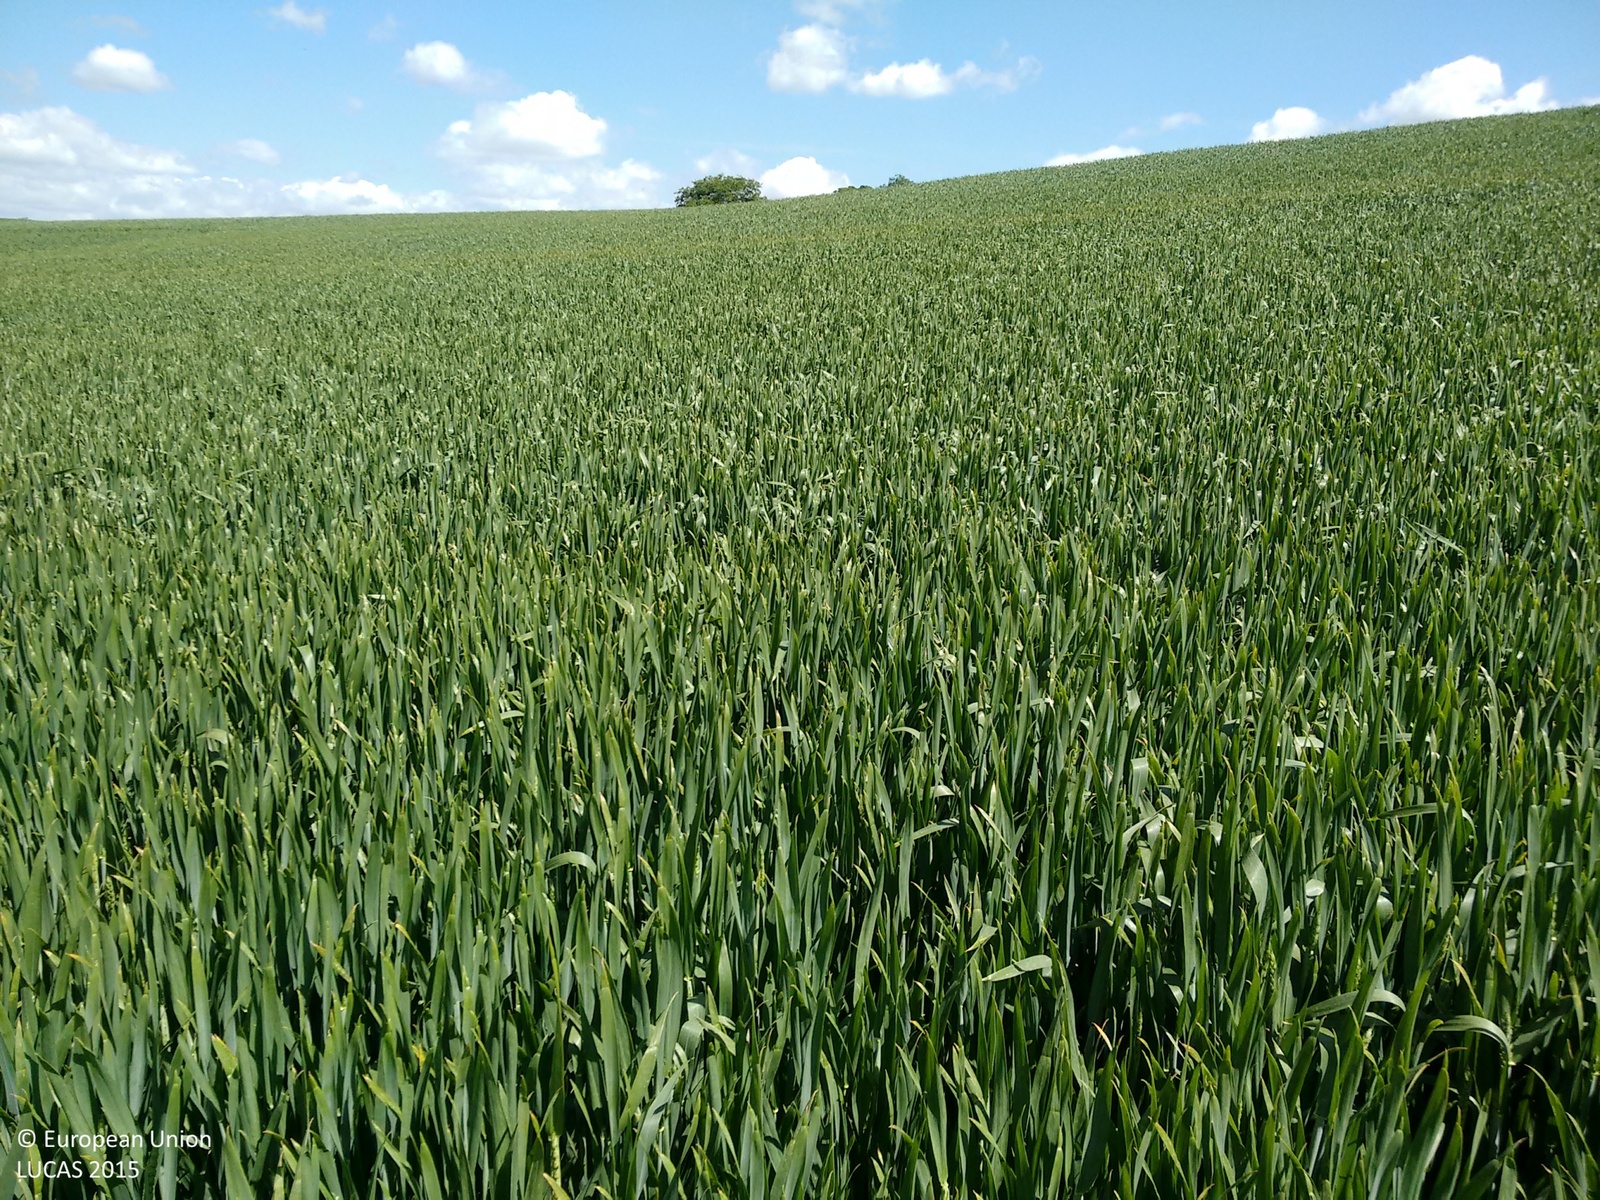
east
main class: Cropland
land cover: Barley
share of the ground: > 75 %
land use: Agriculture (excluding fallow land and kitchen gardens)
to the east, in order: Barley; Grass margins; Lines of trees; Paved roads, cycling and walking lanes; Grass margins; Lines of trees; Common wheat
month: June
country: GB
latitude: 54.1880
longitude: -1.5899
